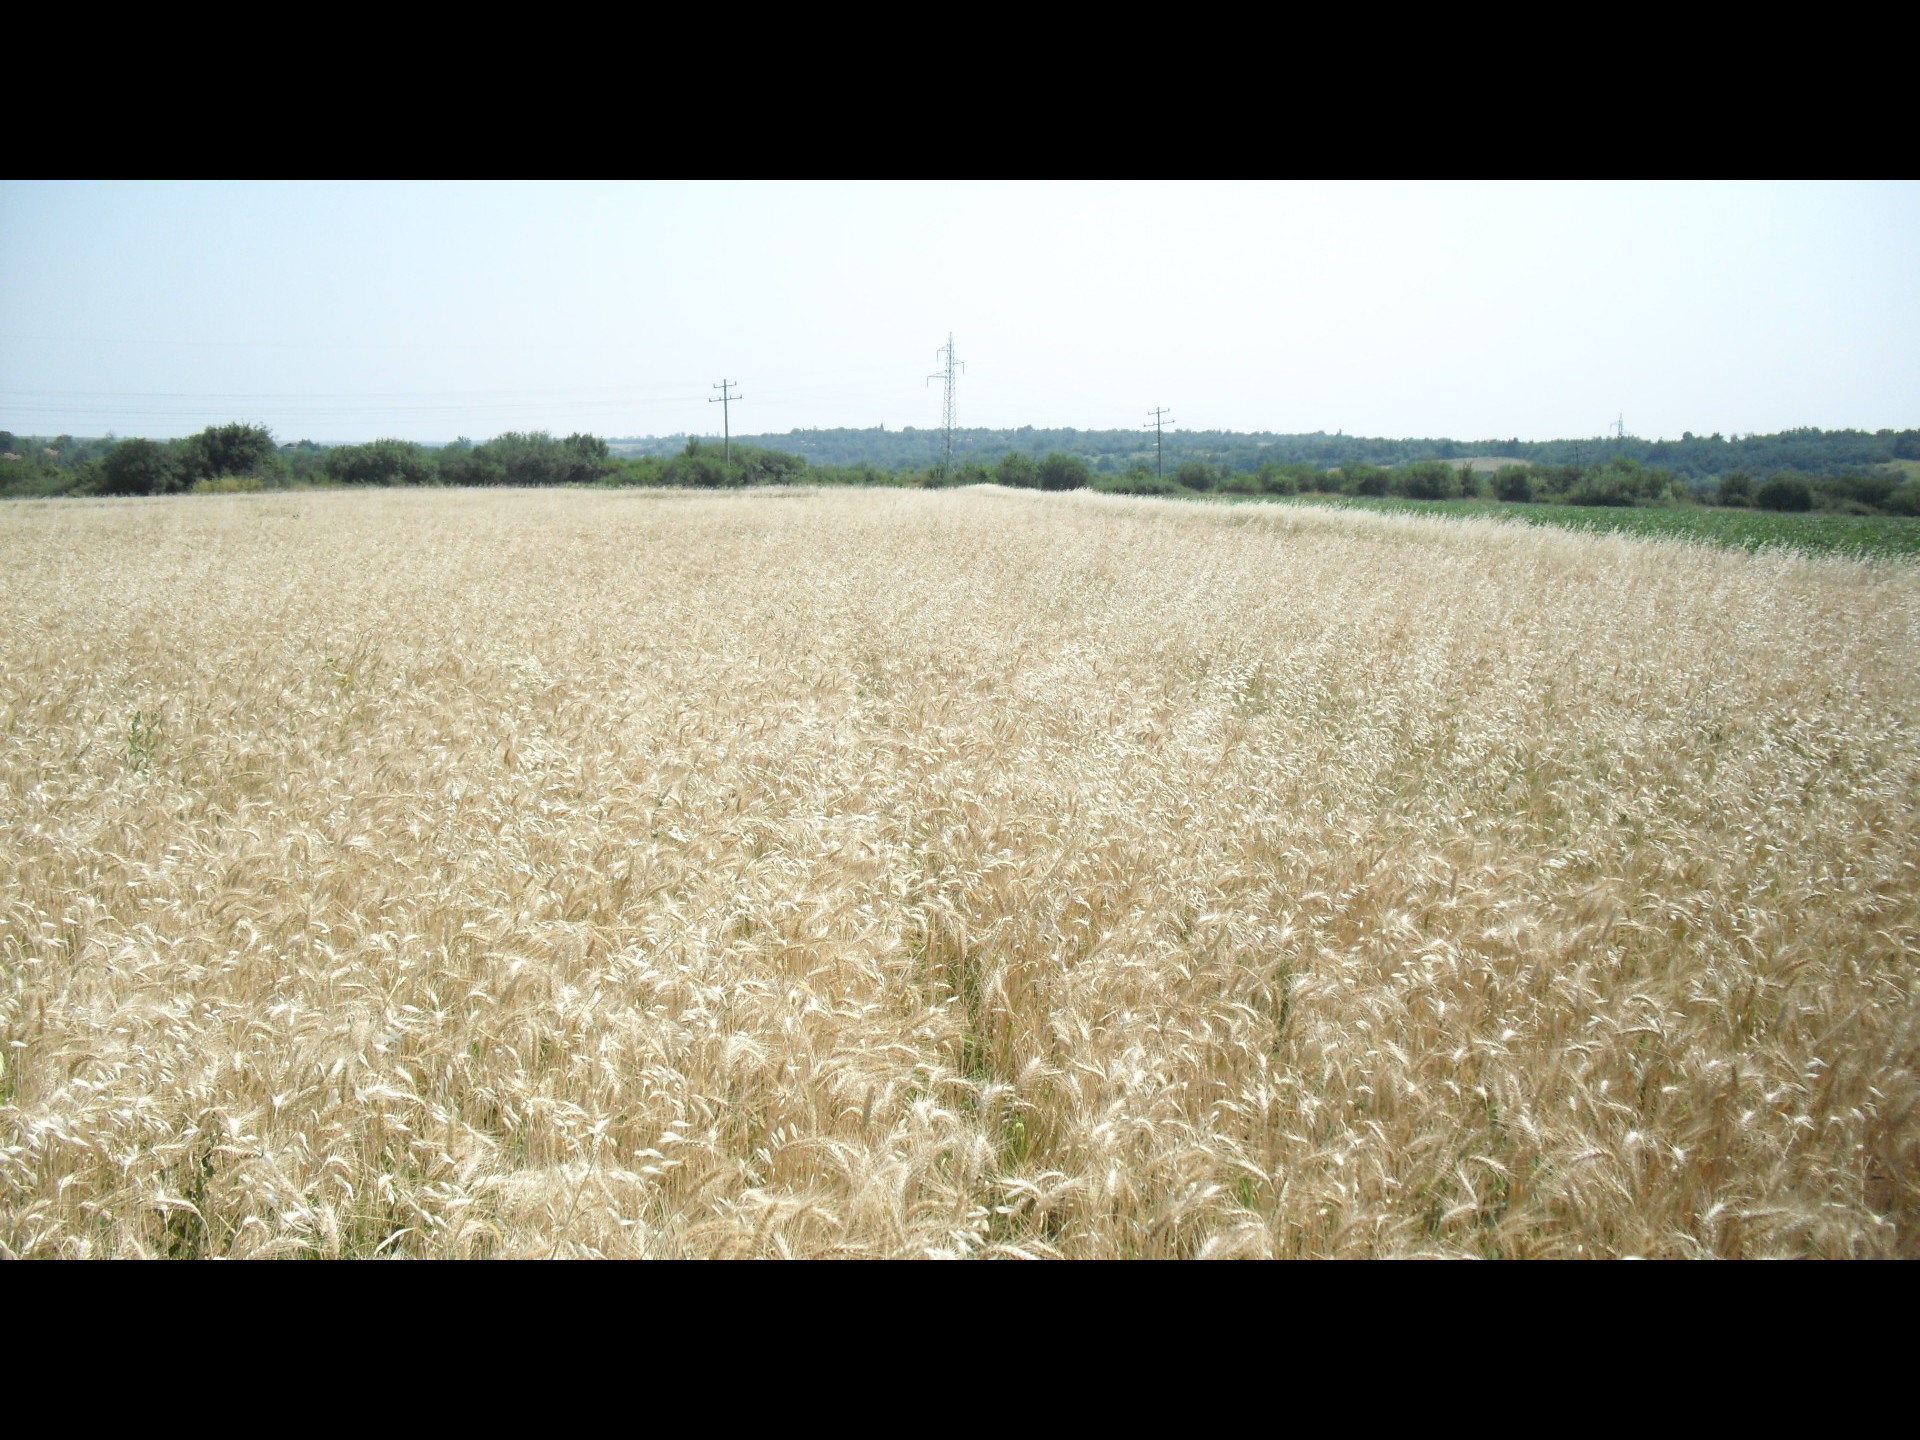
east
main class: Cropland
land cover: Common wheat
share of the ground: > 75 %
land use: Agriculture (excluding fallow land and kitchen gardens)
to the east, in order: Common wheat; Tracks; Soya; Tracks; Shrubland with sparse tree cover; Grass margins; Sunflower
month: July
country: BG
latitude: 43.6494
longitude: 22.7681
